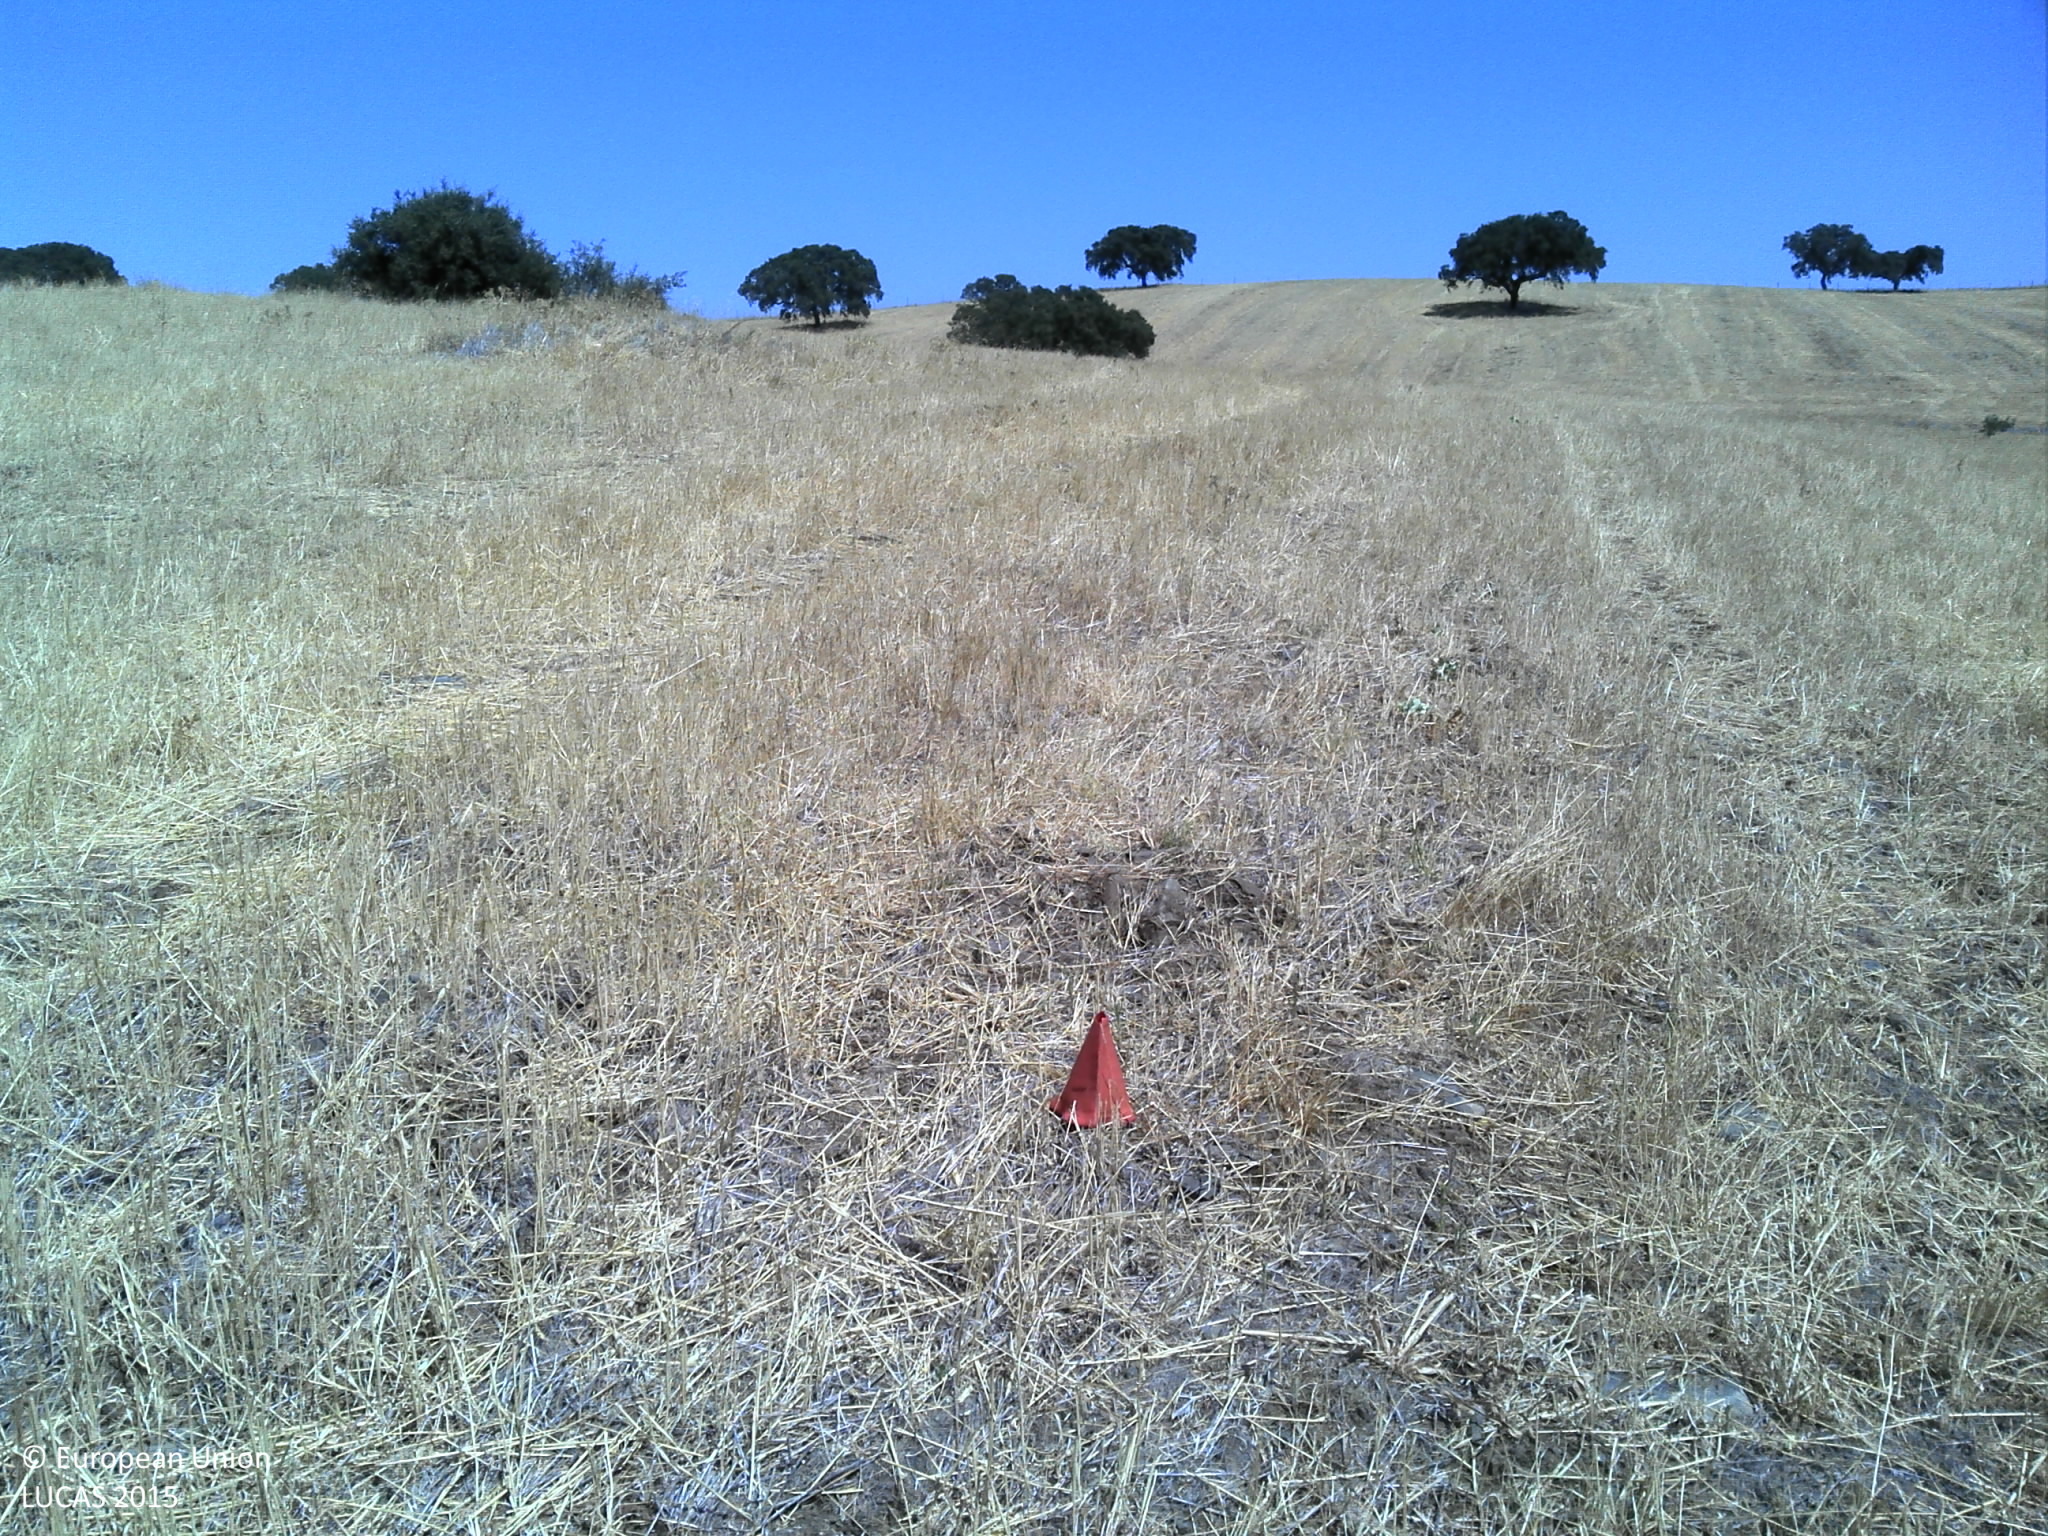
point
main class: Cropland
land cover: Common wheat
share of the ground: > 75 %
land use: Agriculture (excluding fallow land and kitchen gardens)
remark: Harvested field
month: August
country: PT
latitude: 38.0480
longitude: -7.7221
